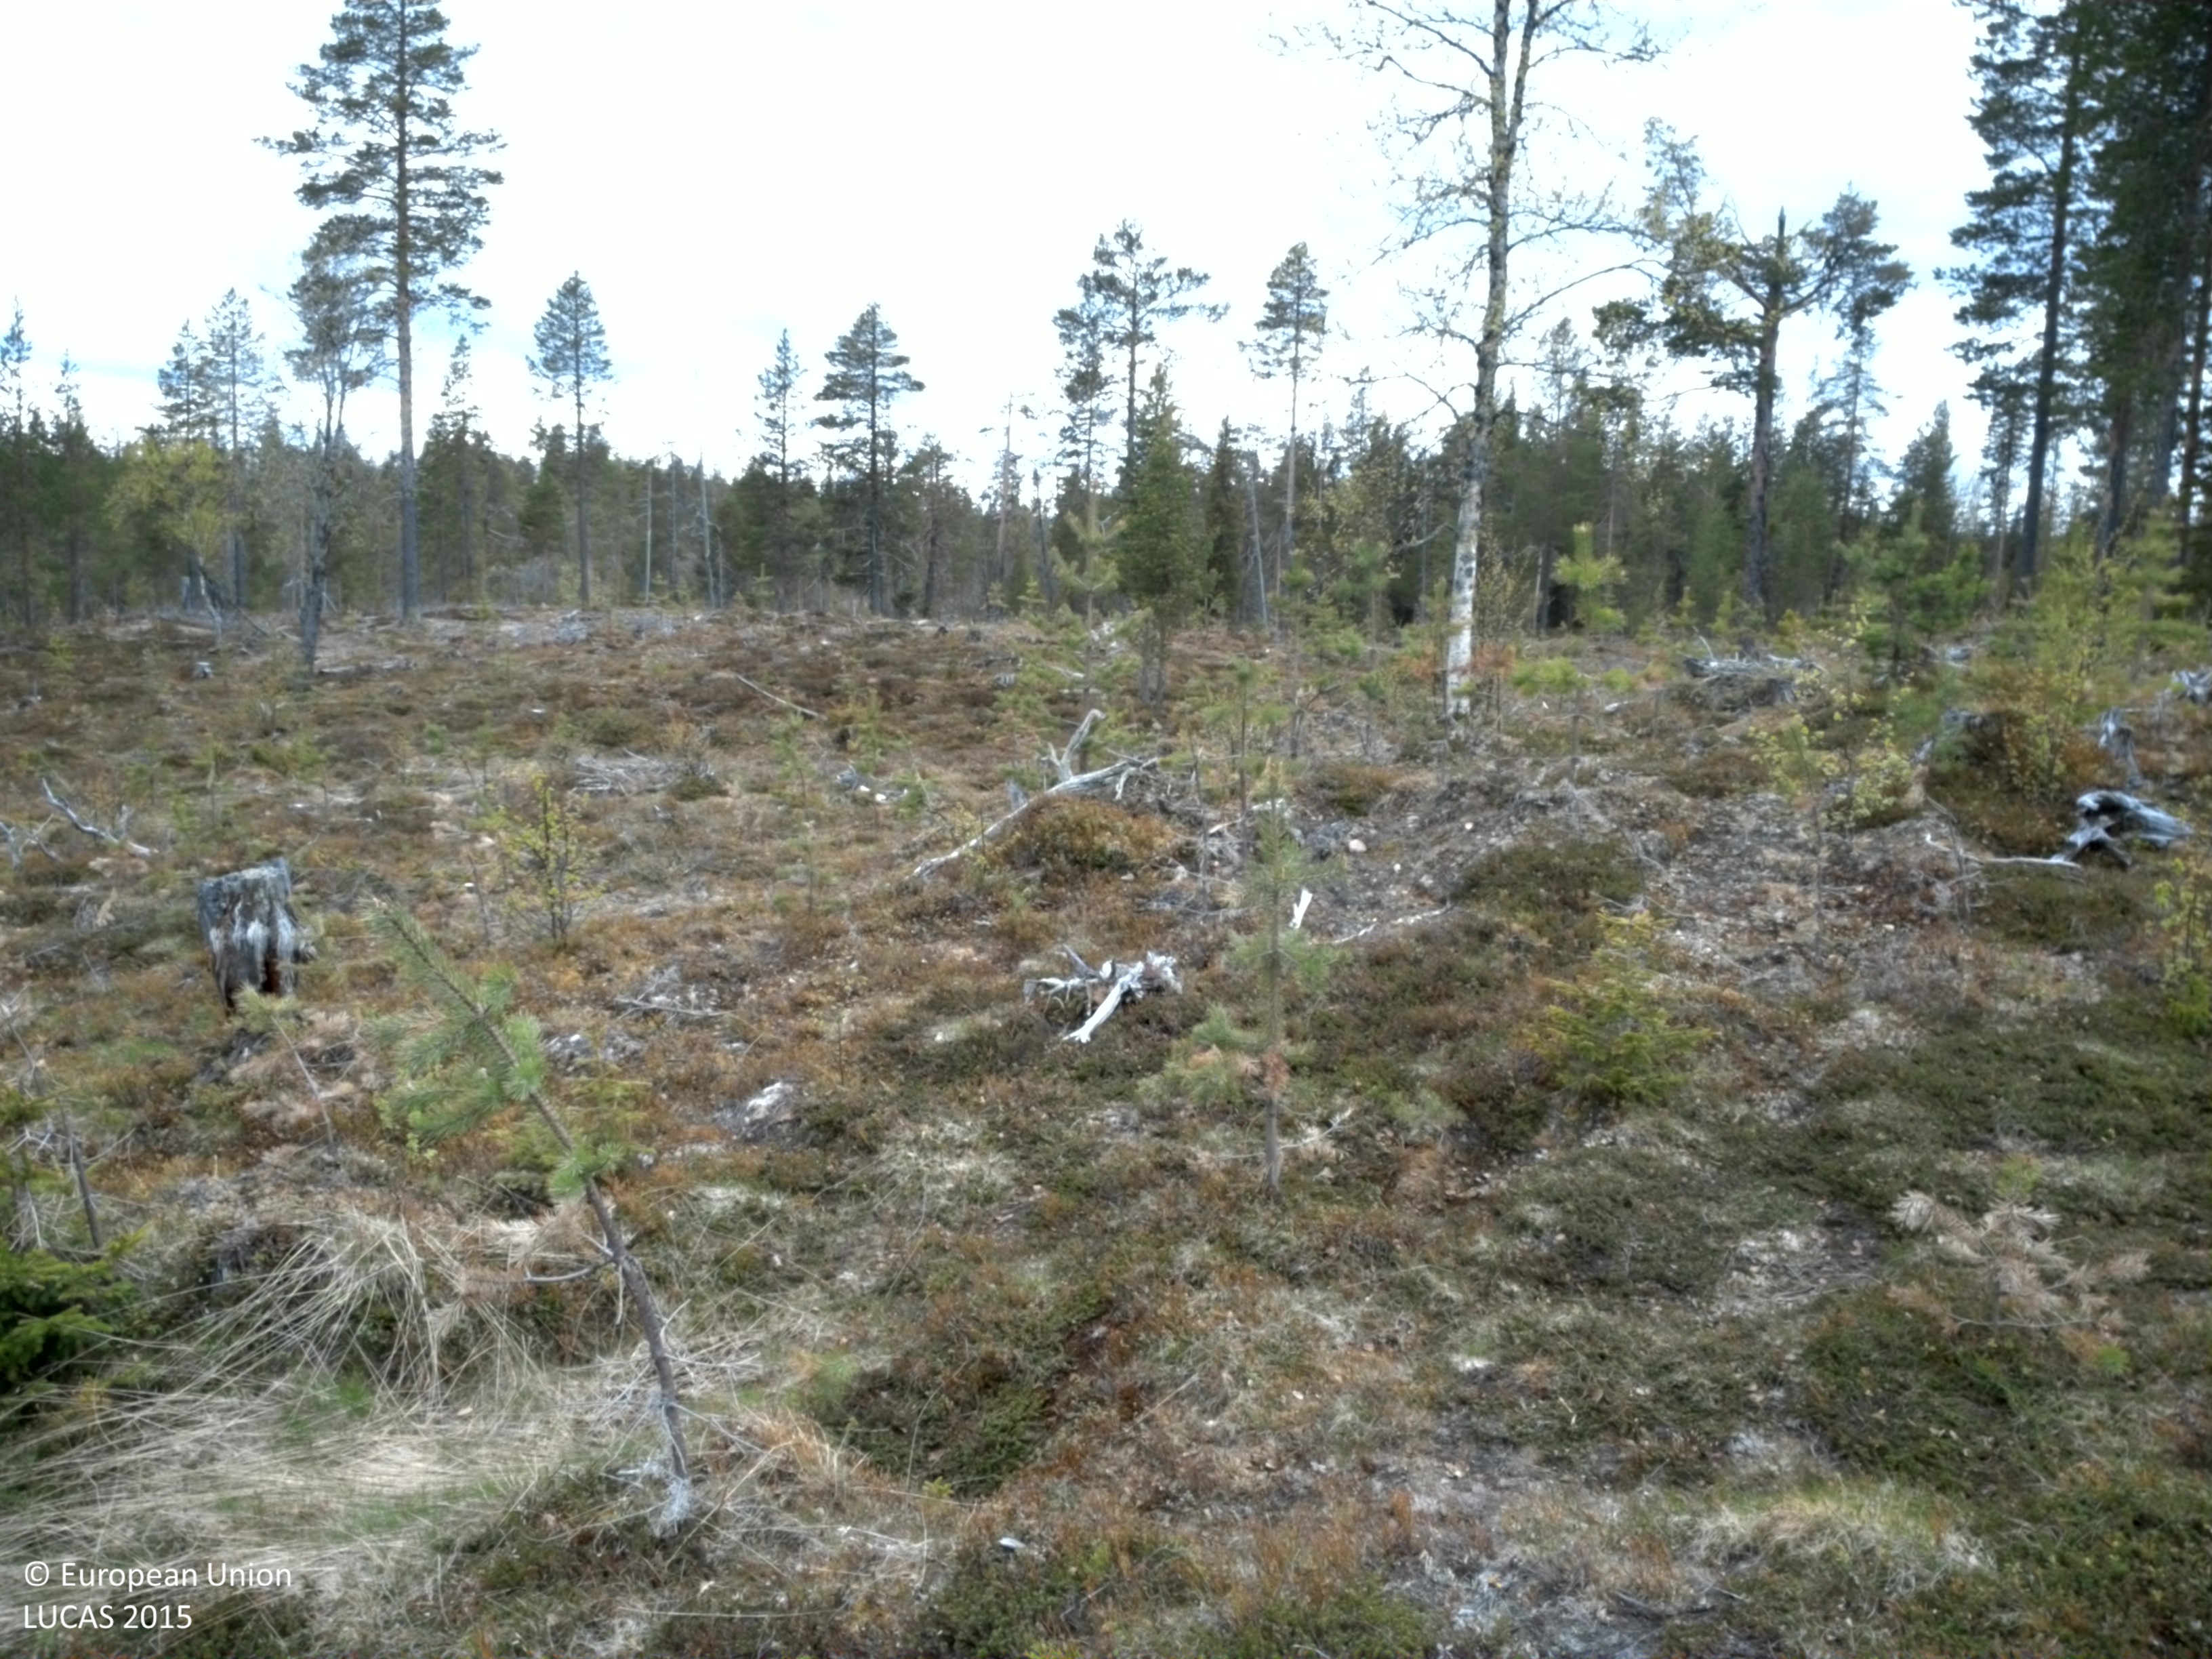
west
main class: Shrubland
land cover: Shrubland with sparse tree cover
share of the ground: > 75 %
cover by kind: shrubs 85 %, herbaceous plants 10 %, coniferous forest trees 5 %
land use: Forestry
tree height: < 5 m
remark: Clear cut
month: June
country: SE
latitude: 66.0399
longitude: 18.5839
